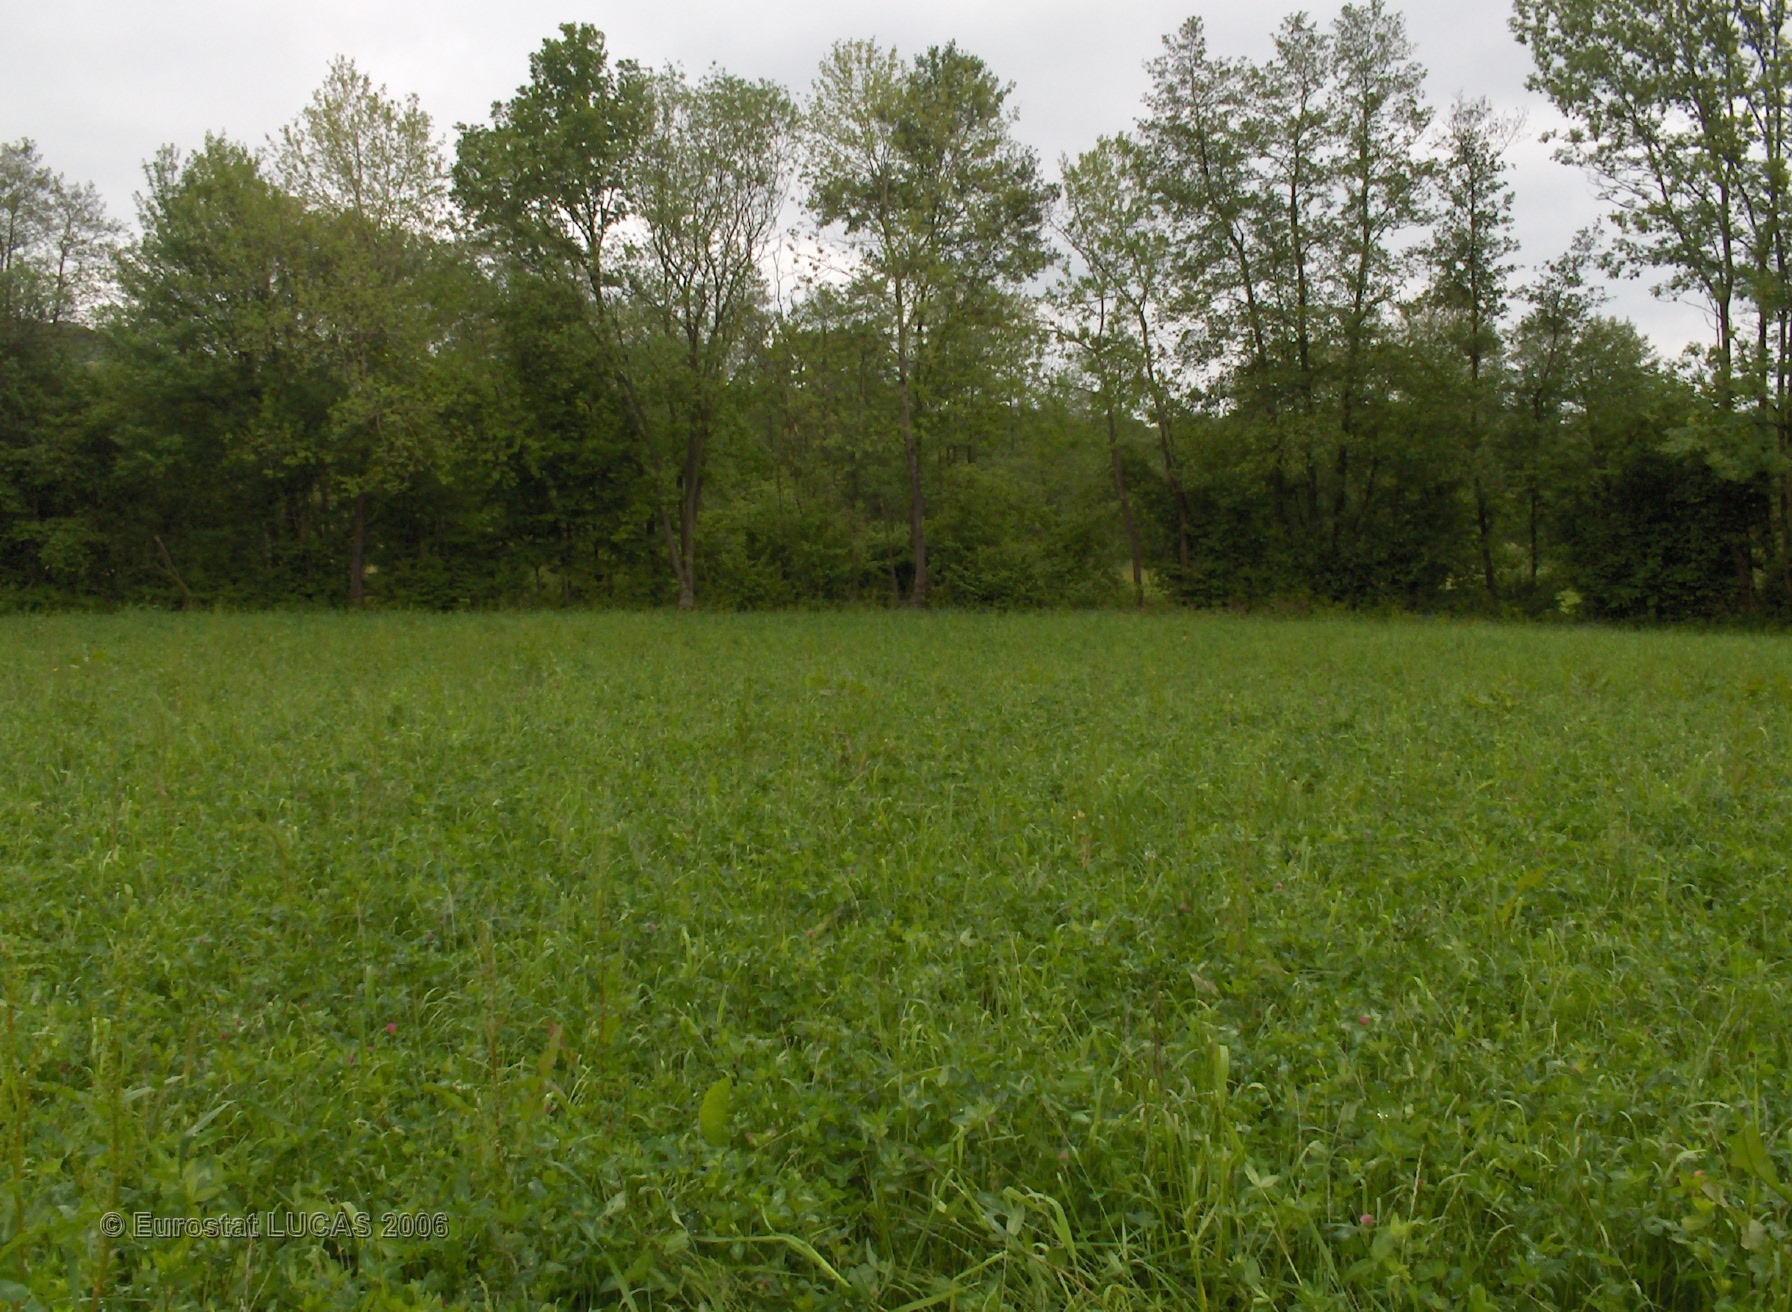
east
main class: Grassland
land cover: Grassland without tree/shrub cover
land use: Agriculture (excluding fallow land and kitchen gardens)
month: June
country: BE
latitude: 50.1634
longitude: 4.5786
